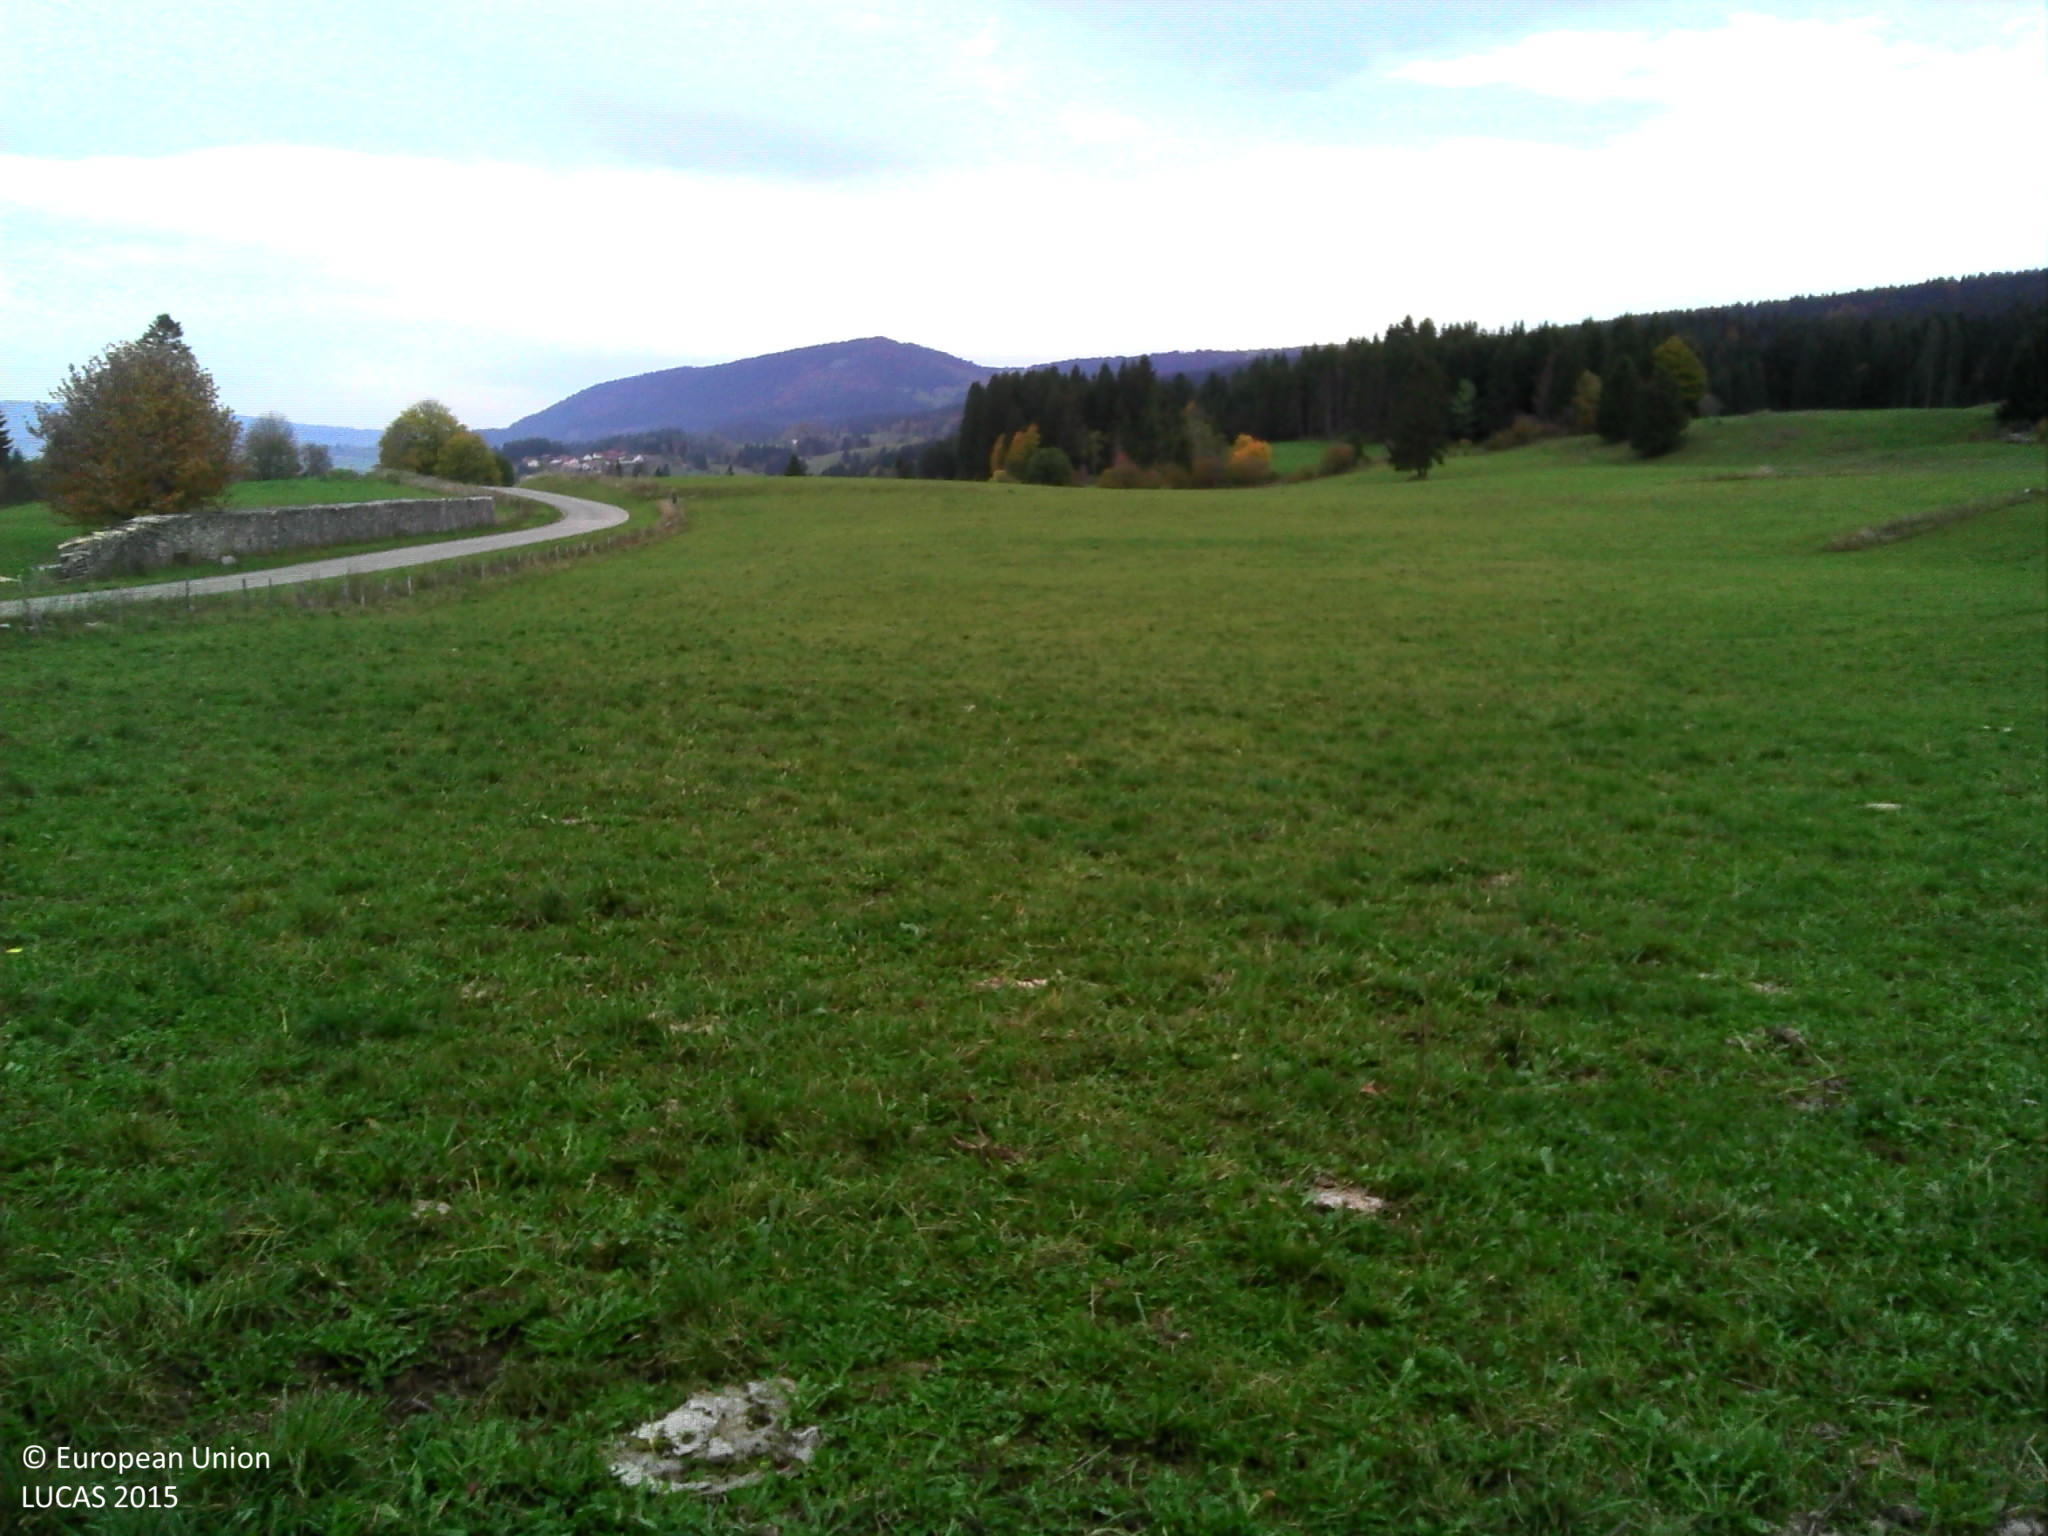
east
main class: Grassland
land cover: Grassland without tree/shrub cover
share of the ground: > 75 %
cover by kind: herbaceous plants 100 %
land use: Agriculture (excluding fallow land and kitchen gardens)
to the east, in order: Grassland without tree/shrub cover
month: October
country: FR
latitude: 46.7370
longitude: 6.2728
